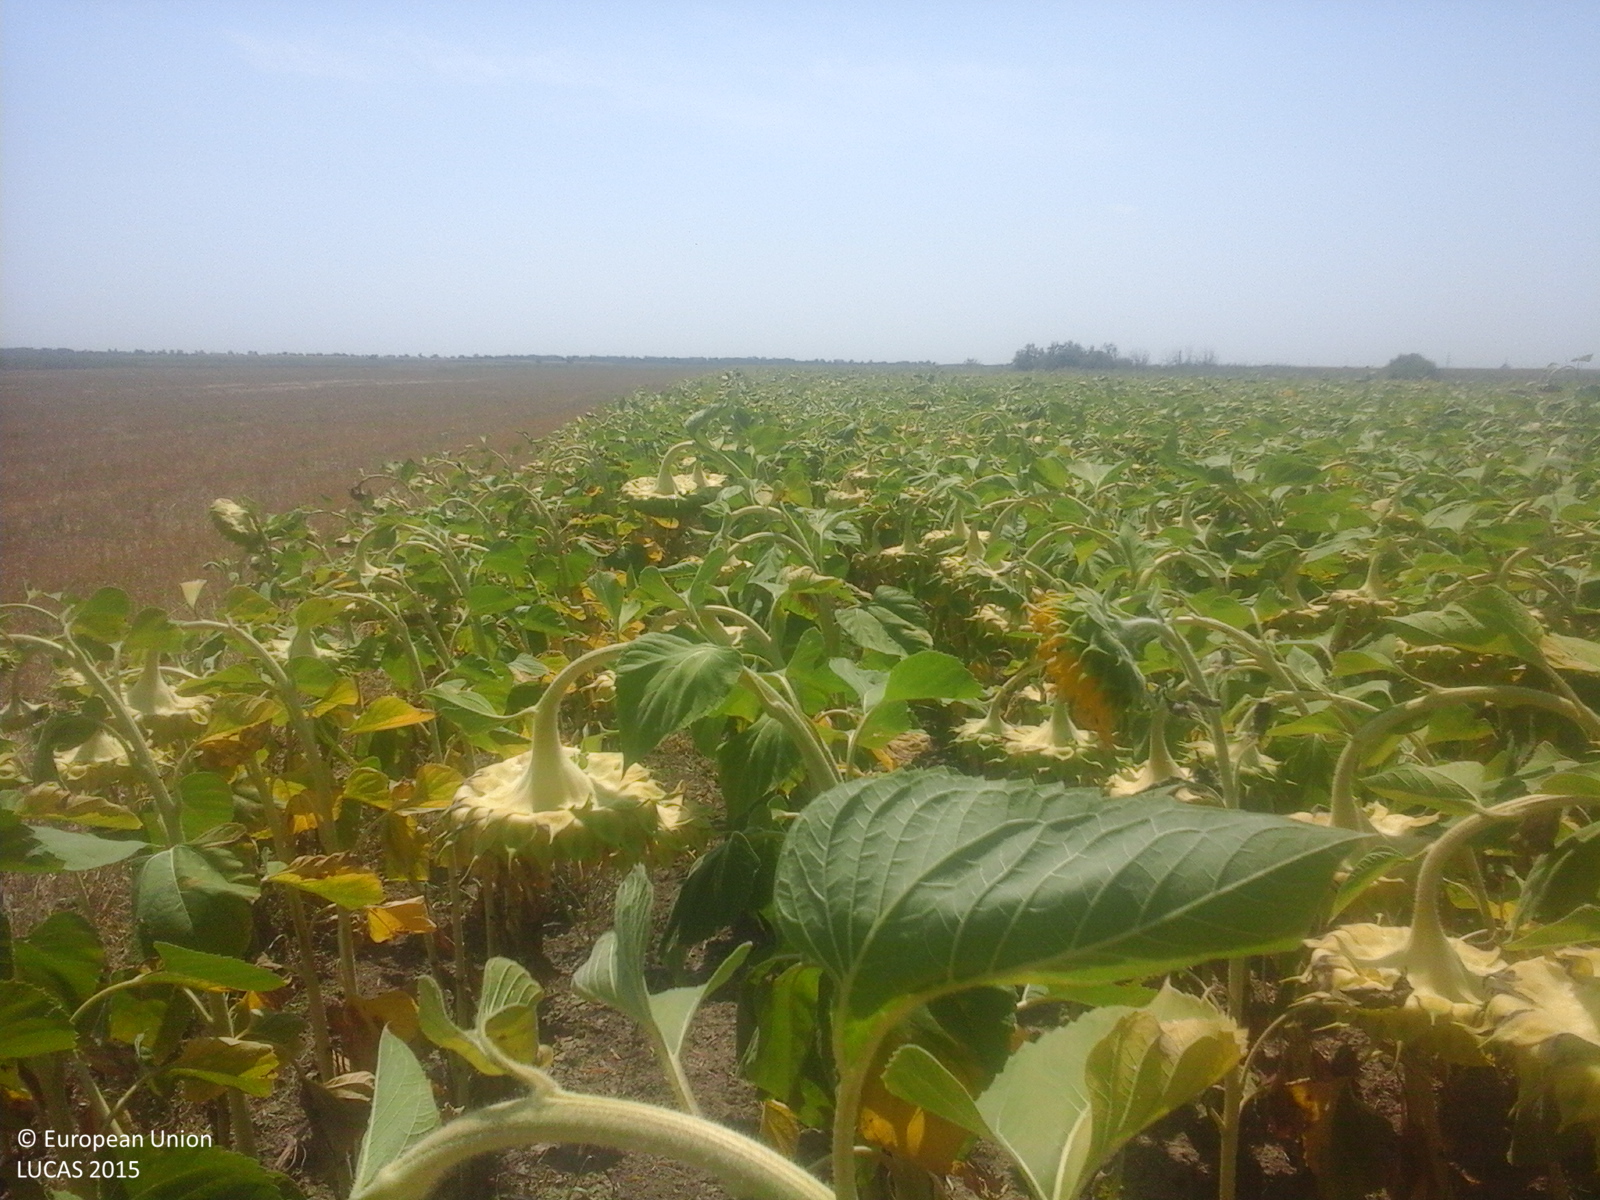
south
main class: Cropland
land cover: Sunflower
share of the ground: > 75 %
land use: Agriculture (excluding fallow land and kitchen gardens)
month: August
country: RO
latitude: 45.5451
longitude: 27.3505
